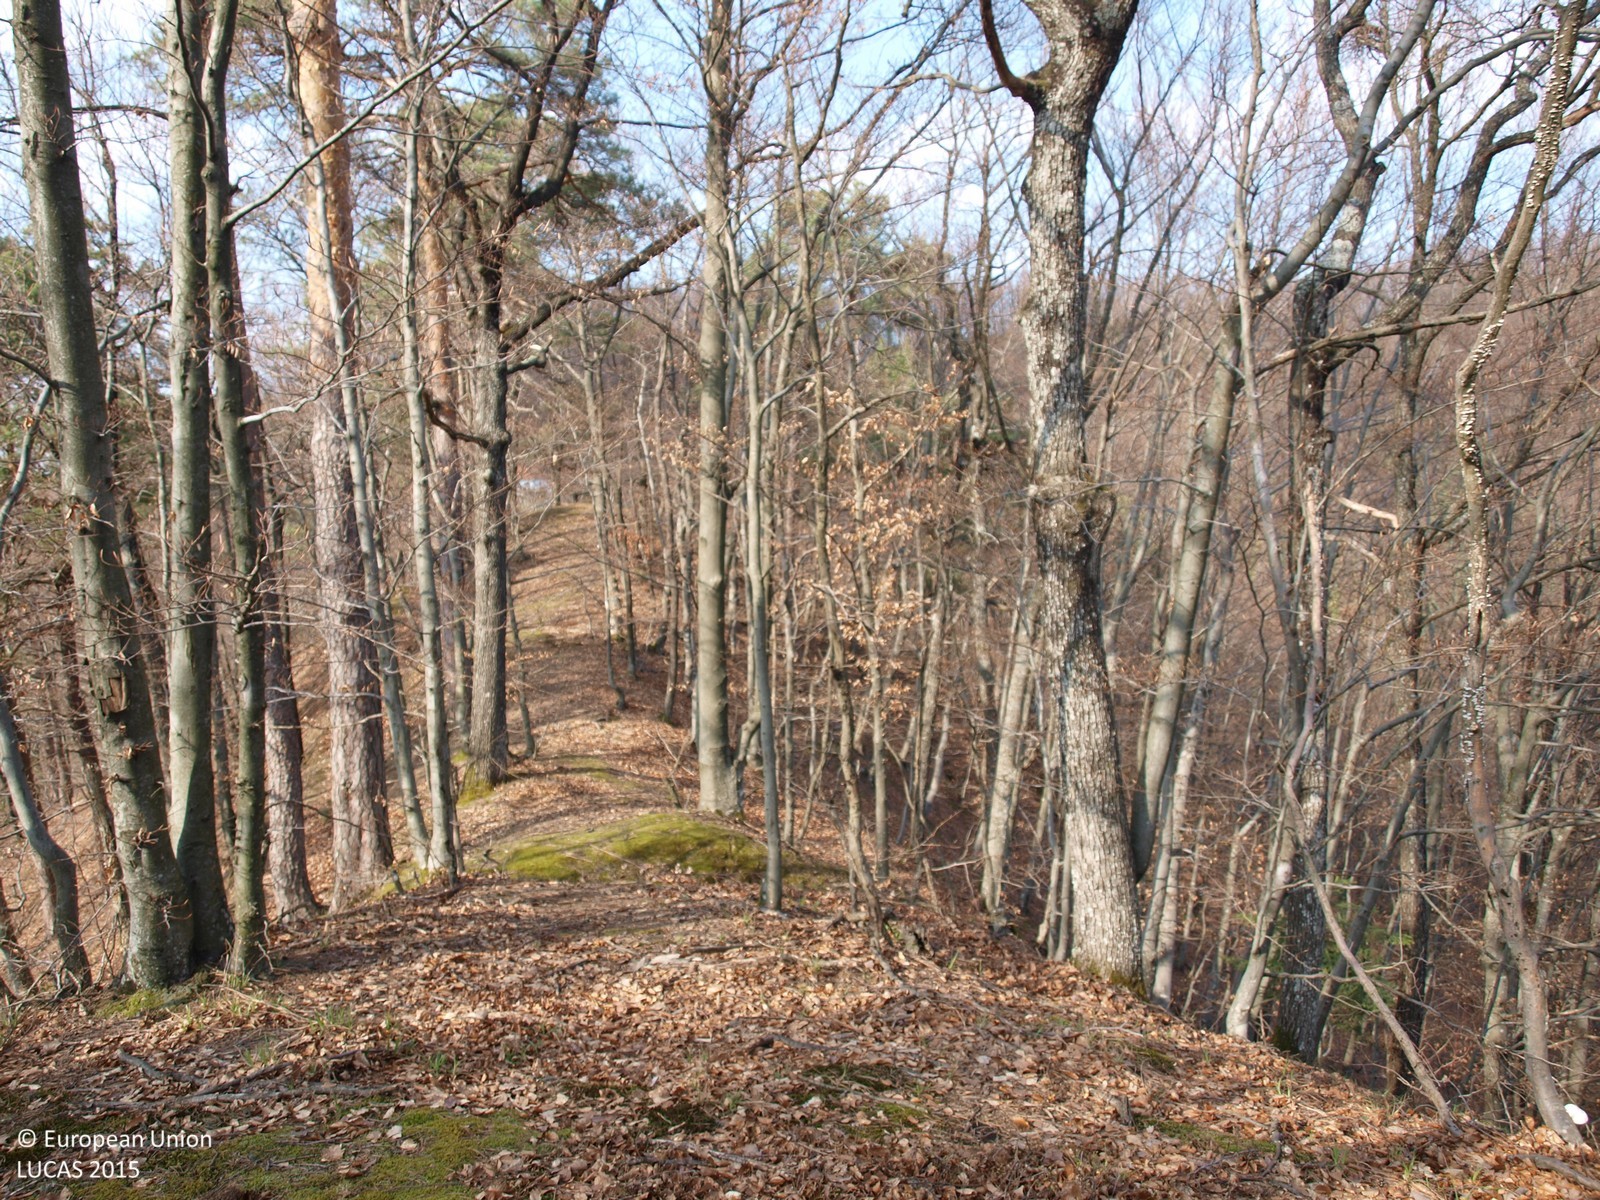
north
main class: Woodland
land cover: Broadleaved woodland
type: mesophytic deciduous forest
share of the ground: > 75 %
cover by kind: broadleaved forest trees 90 %, coniferous forest trees 10 %
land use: Forestry
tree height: > 5 m
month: March
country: HR
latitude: 46.2935
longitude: 15.9575
